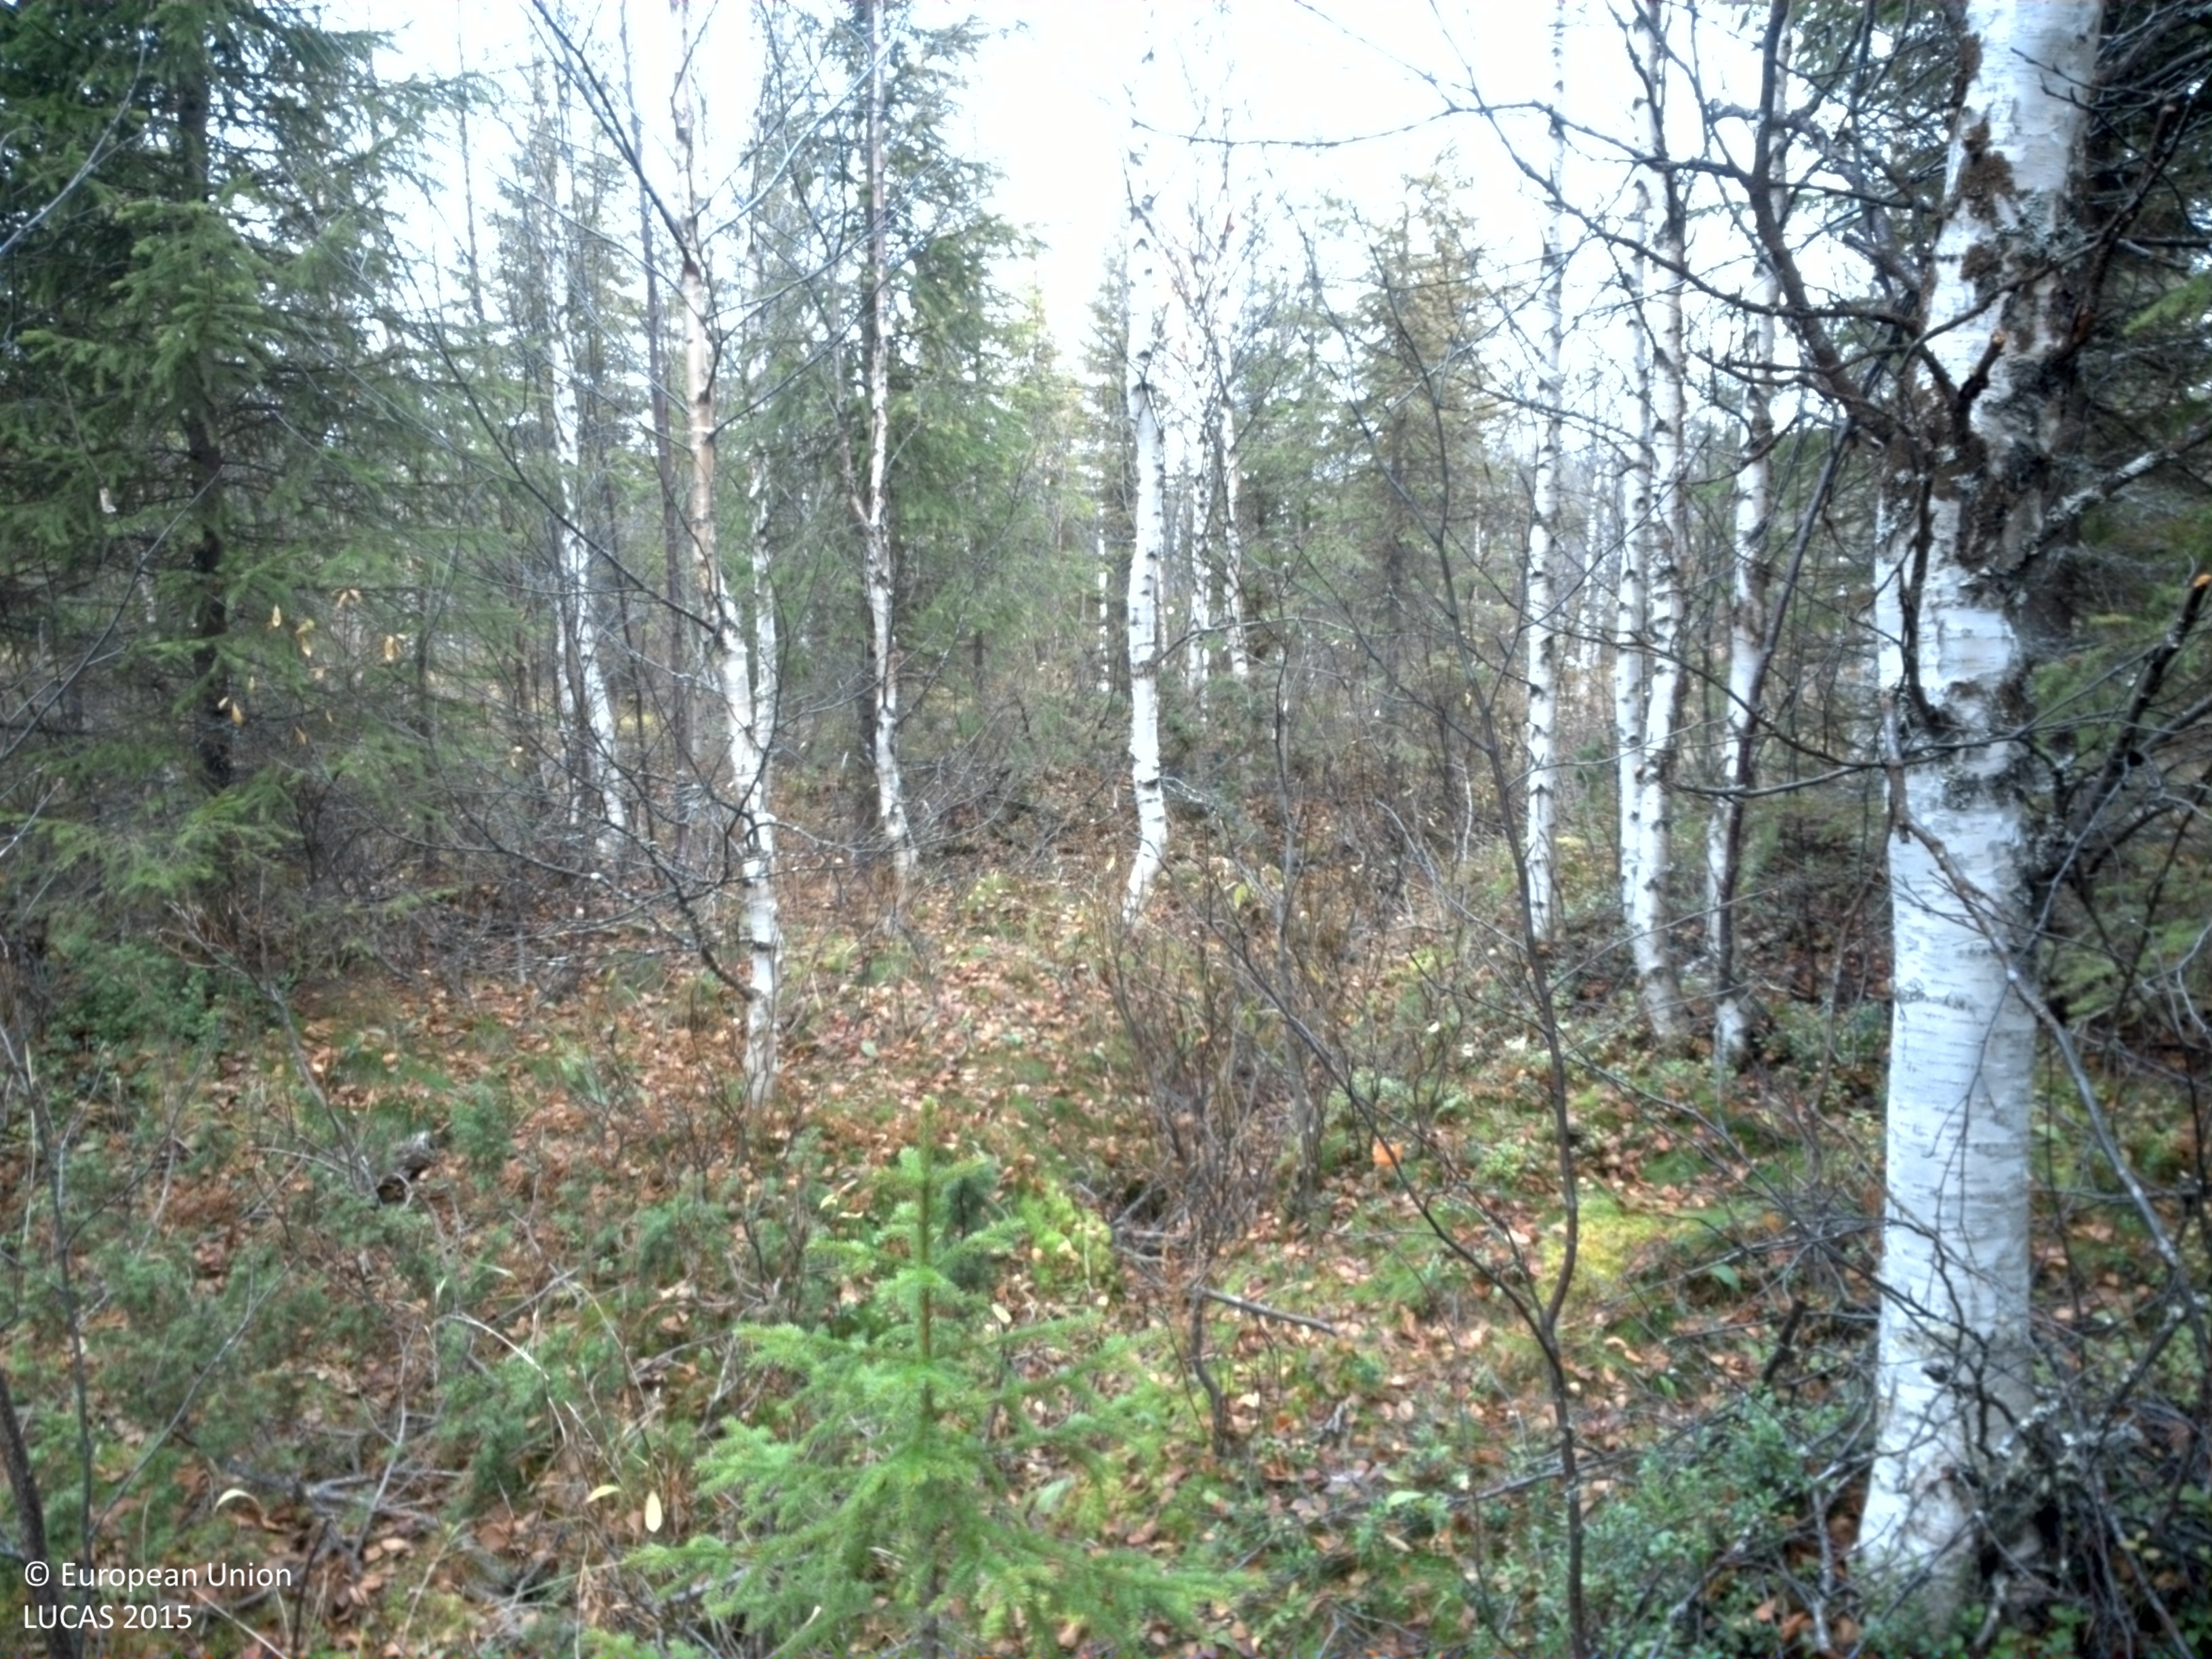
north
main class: Woodland
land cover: Spruce dominated mixed woodland
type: boreal forest
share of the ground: 50 - 75 %
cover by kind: shrubs 30 %, coniferous forest trees 25 %, broadleaved forest trees 25 %, herbaceous plants 15 %, lichens and mosses 5 %
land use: Forestry
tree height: > 5 m
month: October
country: SE
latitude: 64.9327
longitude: 17.0085
